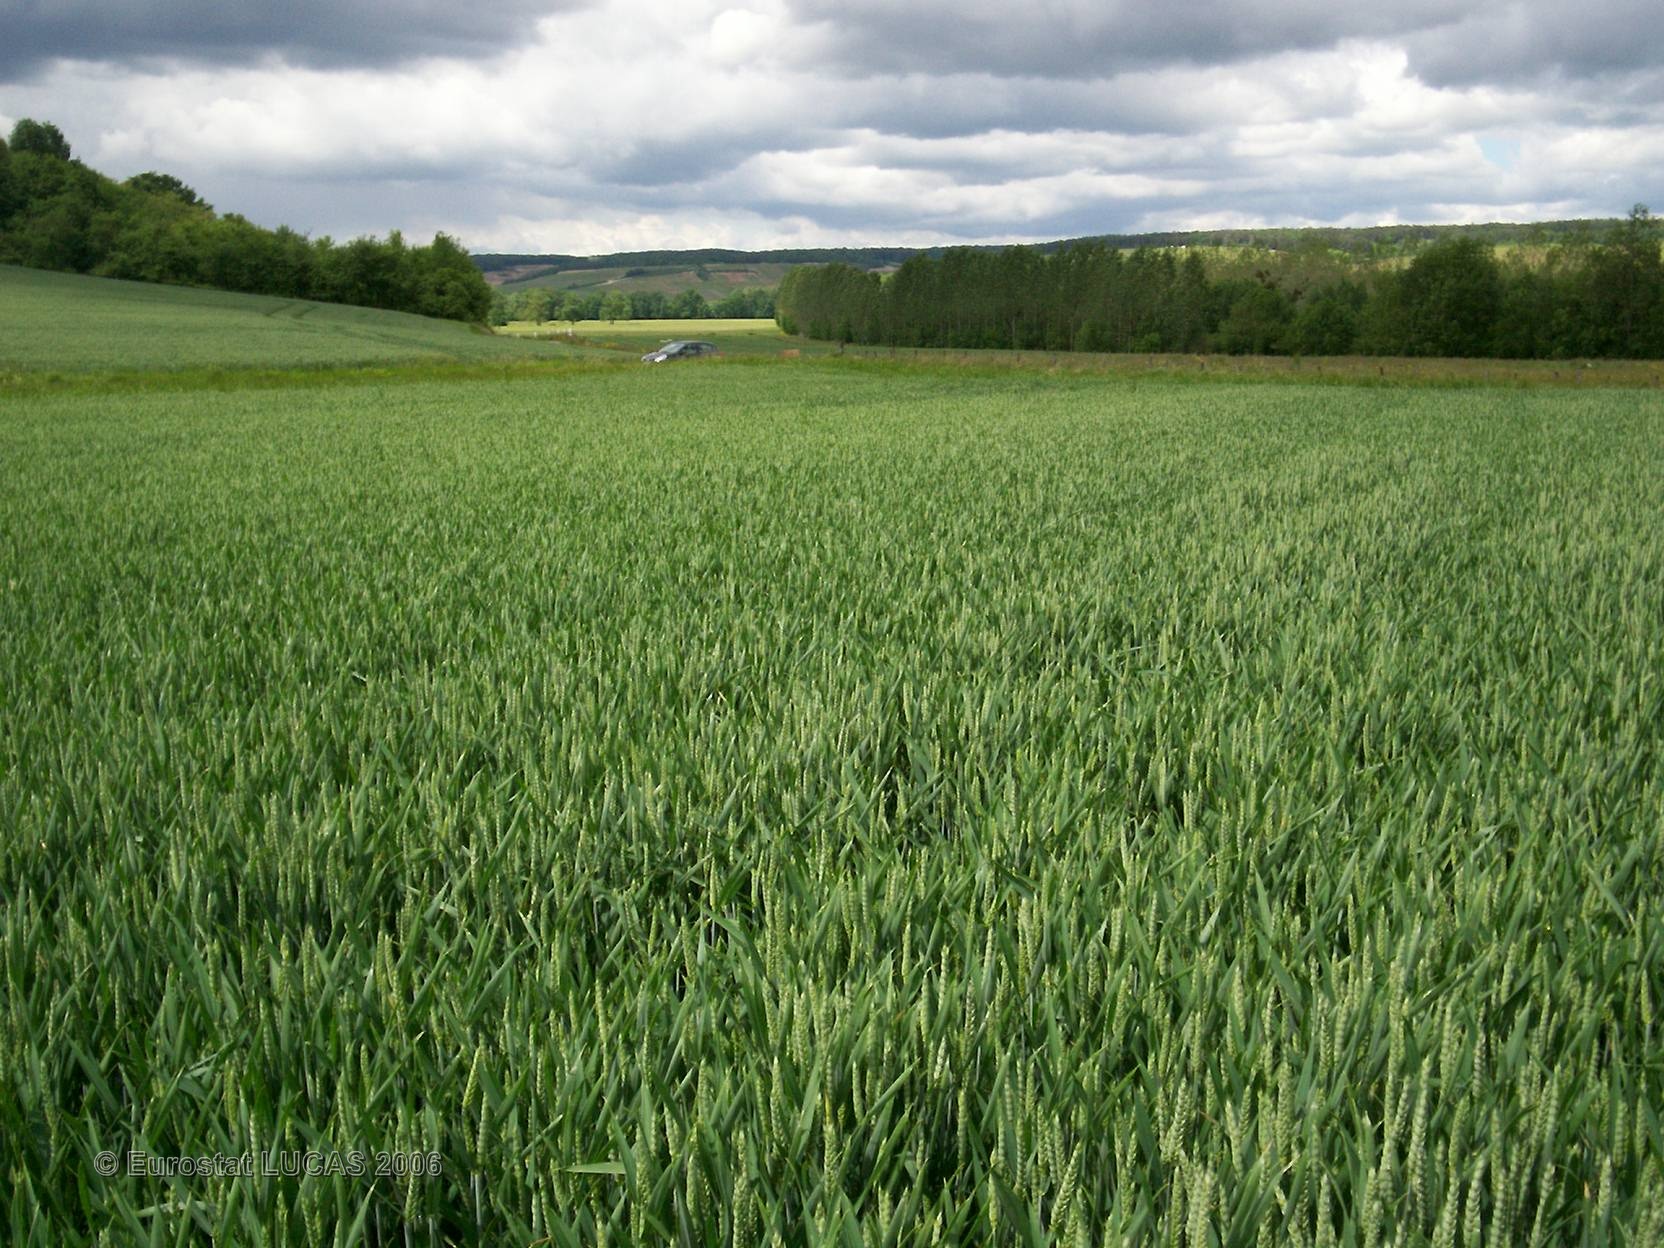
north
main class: Cropland
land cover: Common wheat
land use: Agriculture (excluding fallow land and kitchen gardens)
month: May
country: FR
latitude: 48.2394
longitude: 4.6795
